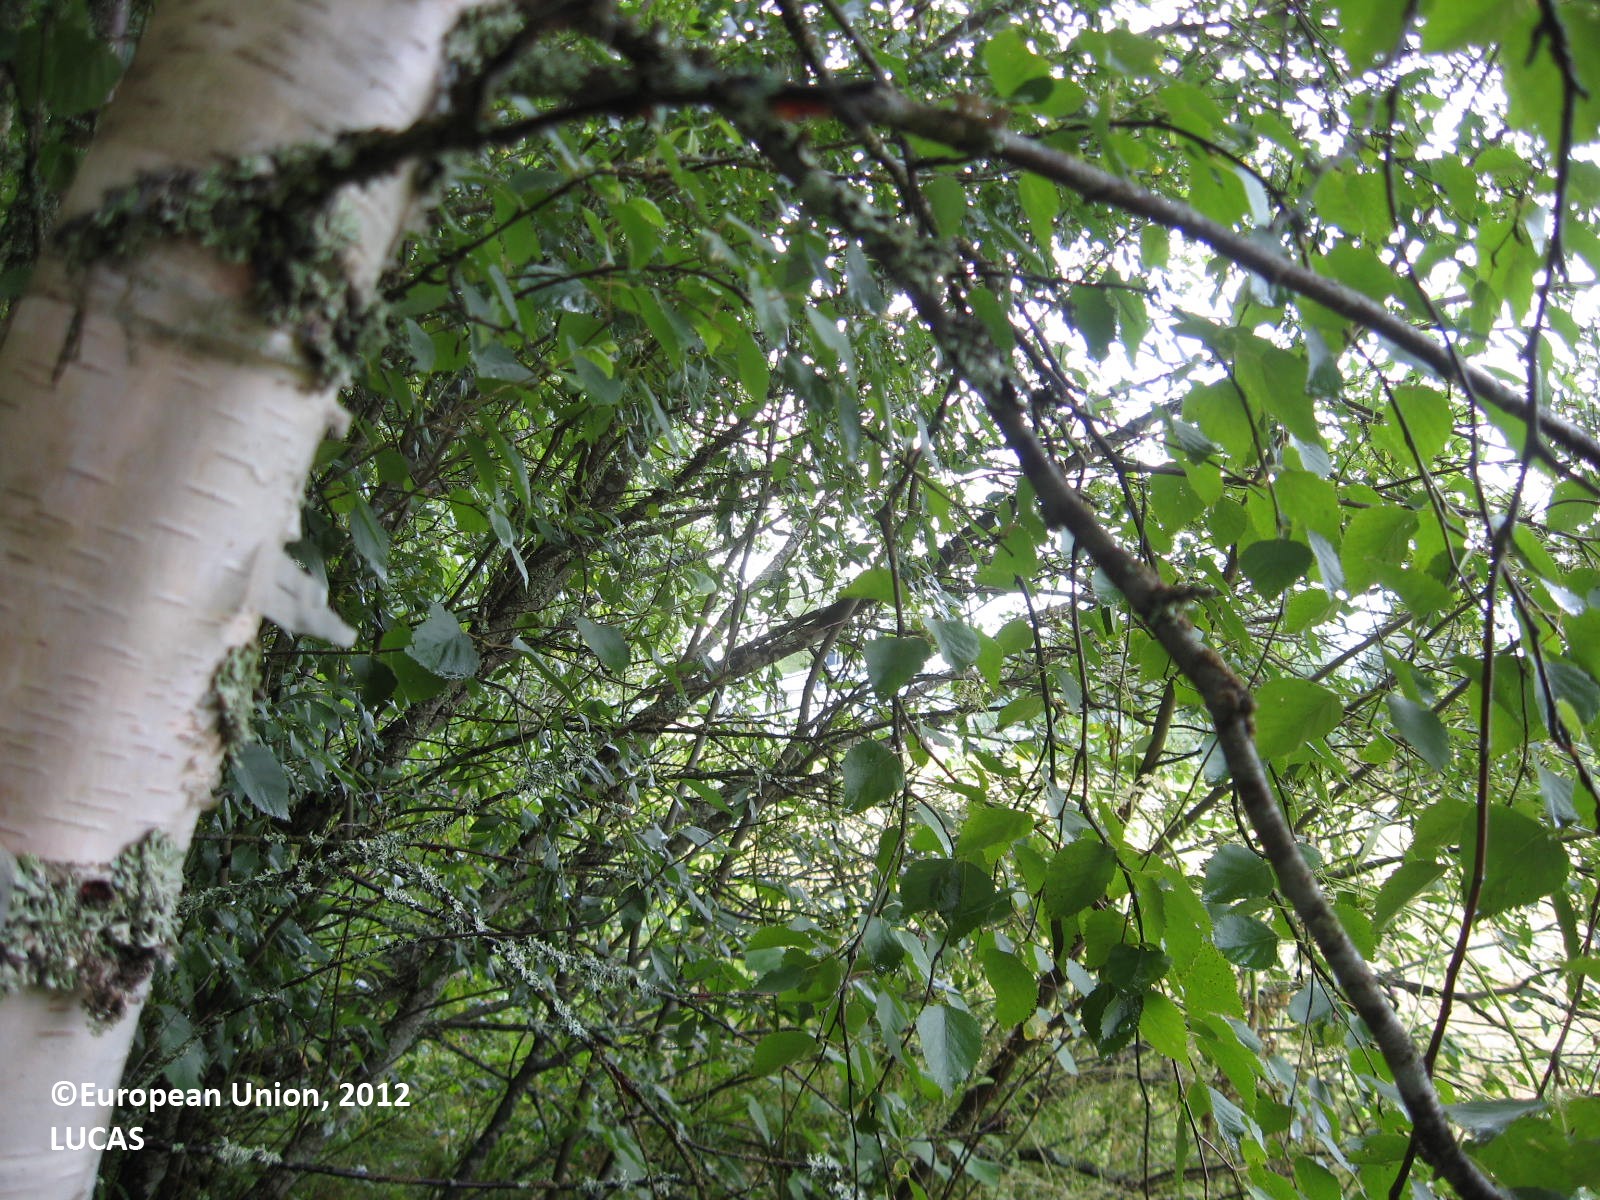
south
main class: Woodland
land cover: Broadleaved woodland
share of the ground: > 75 %
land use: Forestry
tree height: > 5 m
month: July
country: FI
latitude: 62.0870
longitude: 22.5249
